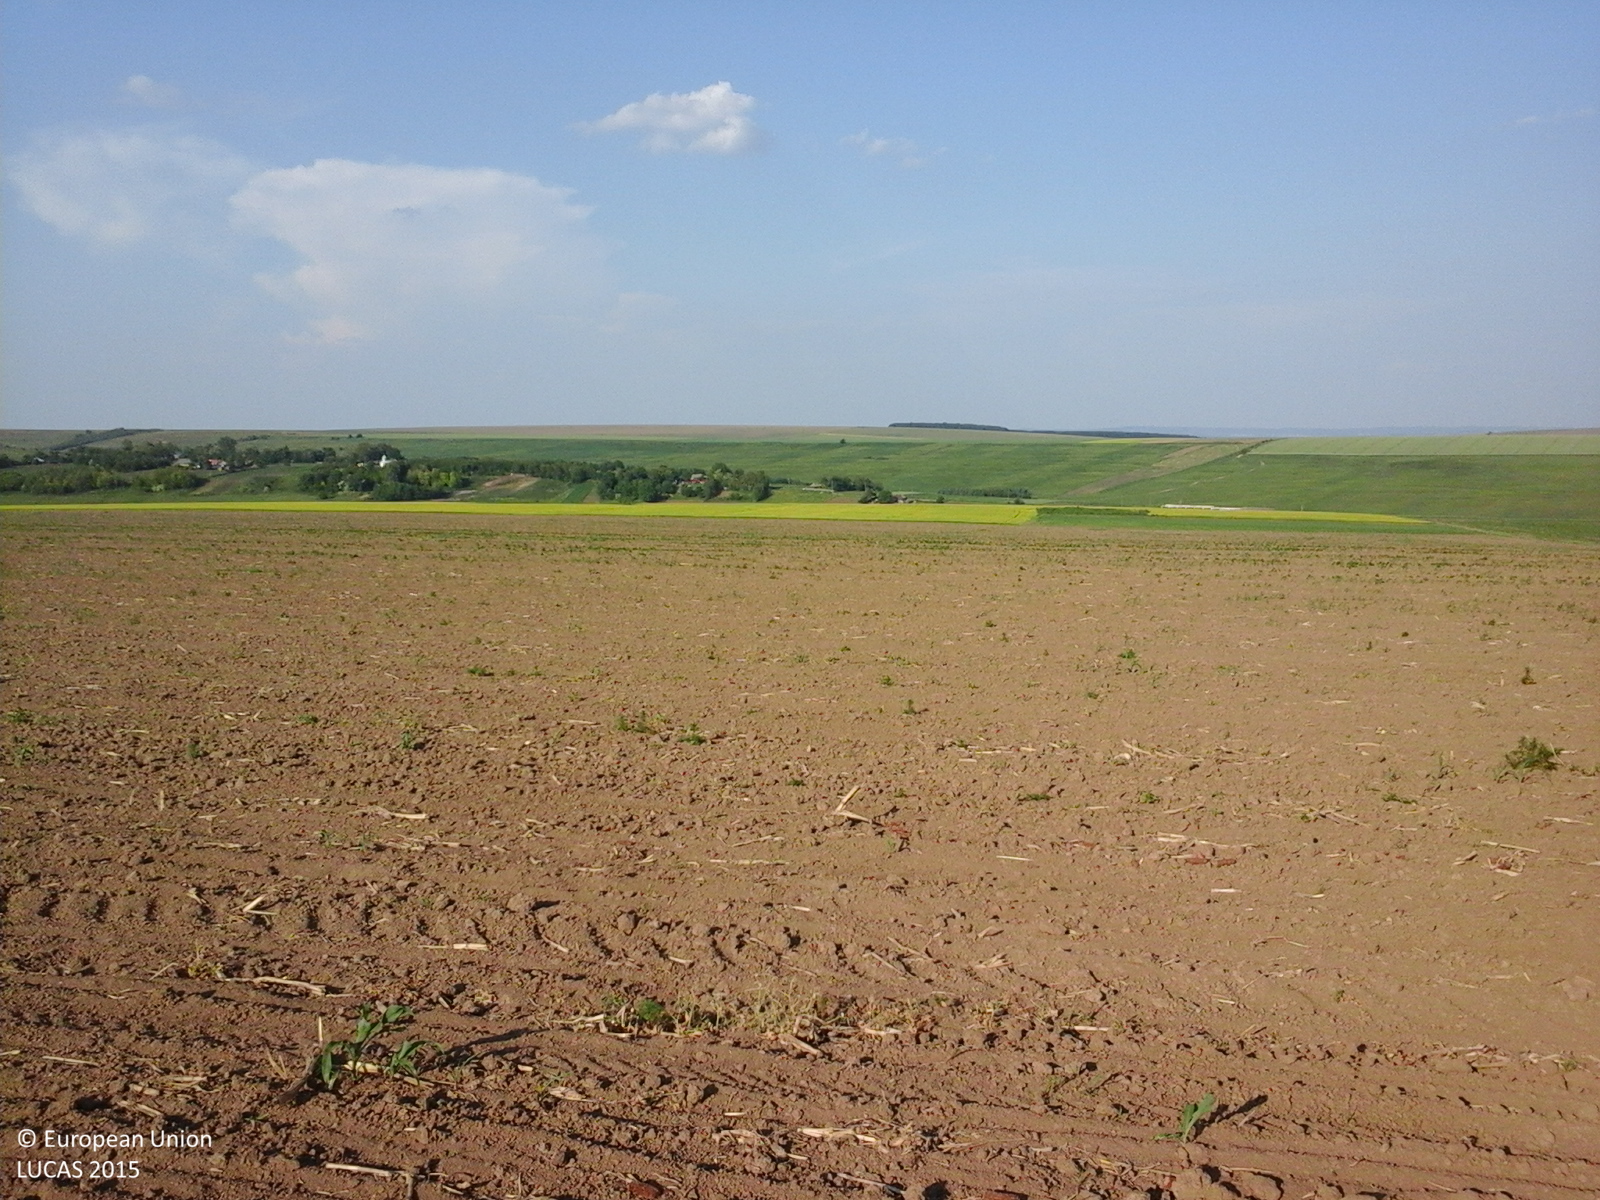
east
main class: Cropland
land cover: Maize
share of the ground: < 10 %
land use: Agriculture (excluding fallow land and kitchen gardens)
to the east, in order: Maize
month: June
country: RO
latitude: 46.8625
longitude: 26.7103
